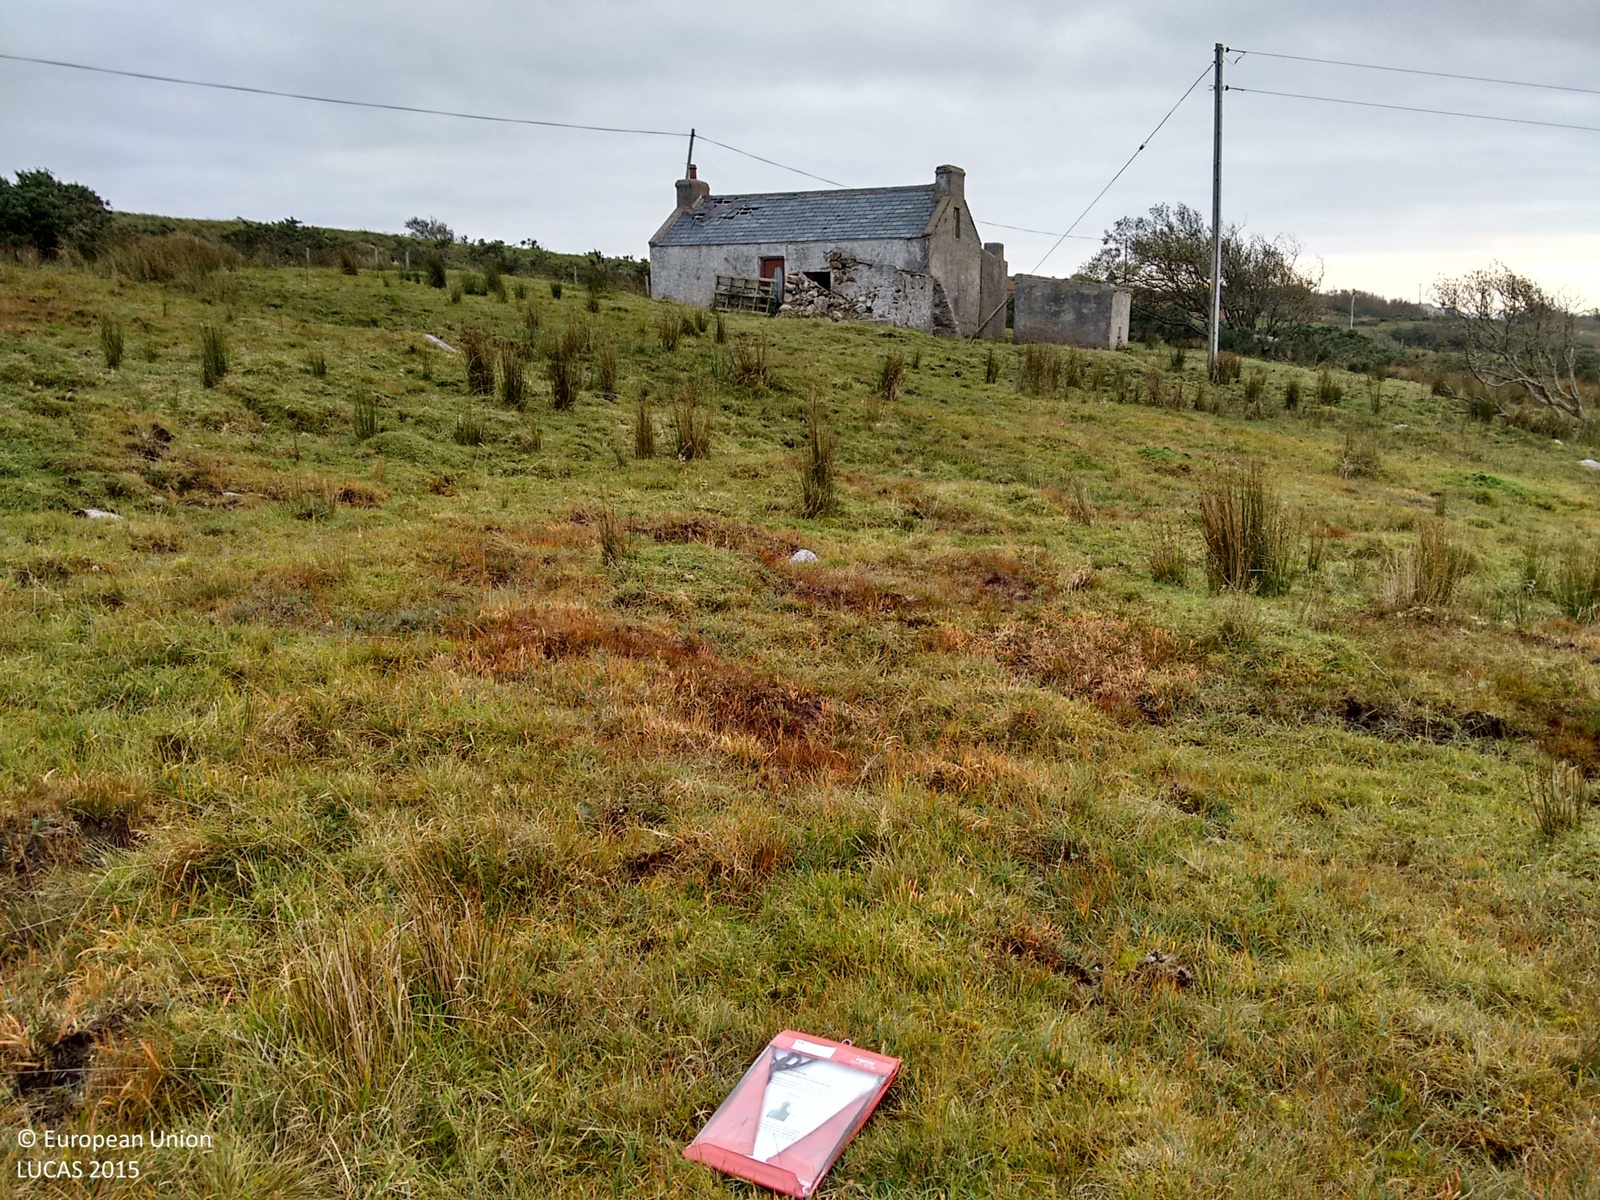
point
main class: Grassland
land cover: Grassland without tree/shrub cover
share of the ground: > 75 %
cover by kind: herbaceous plants 70 %, lichens and mosses 30 %
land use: Agriculture (excluding fallow land and kitchen gardens)
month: November
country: IE
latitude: 54.9796
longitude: -8.3237
